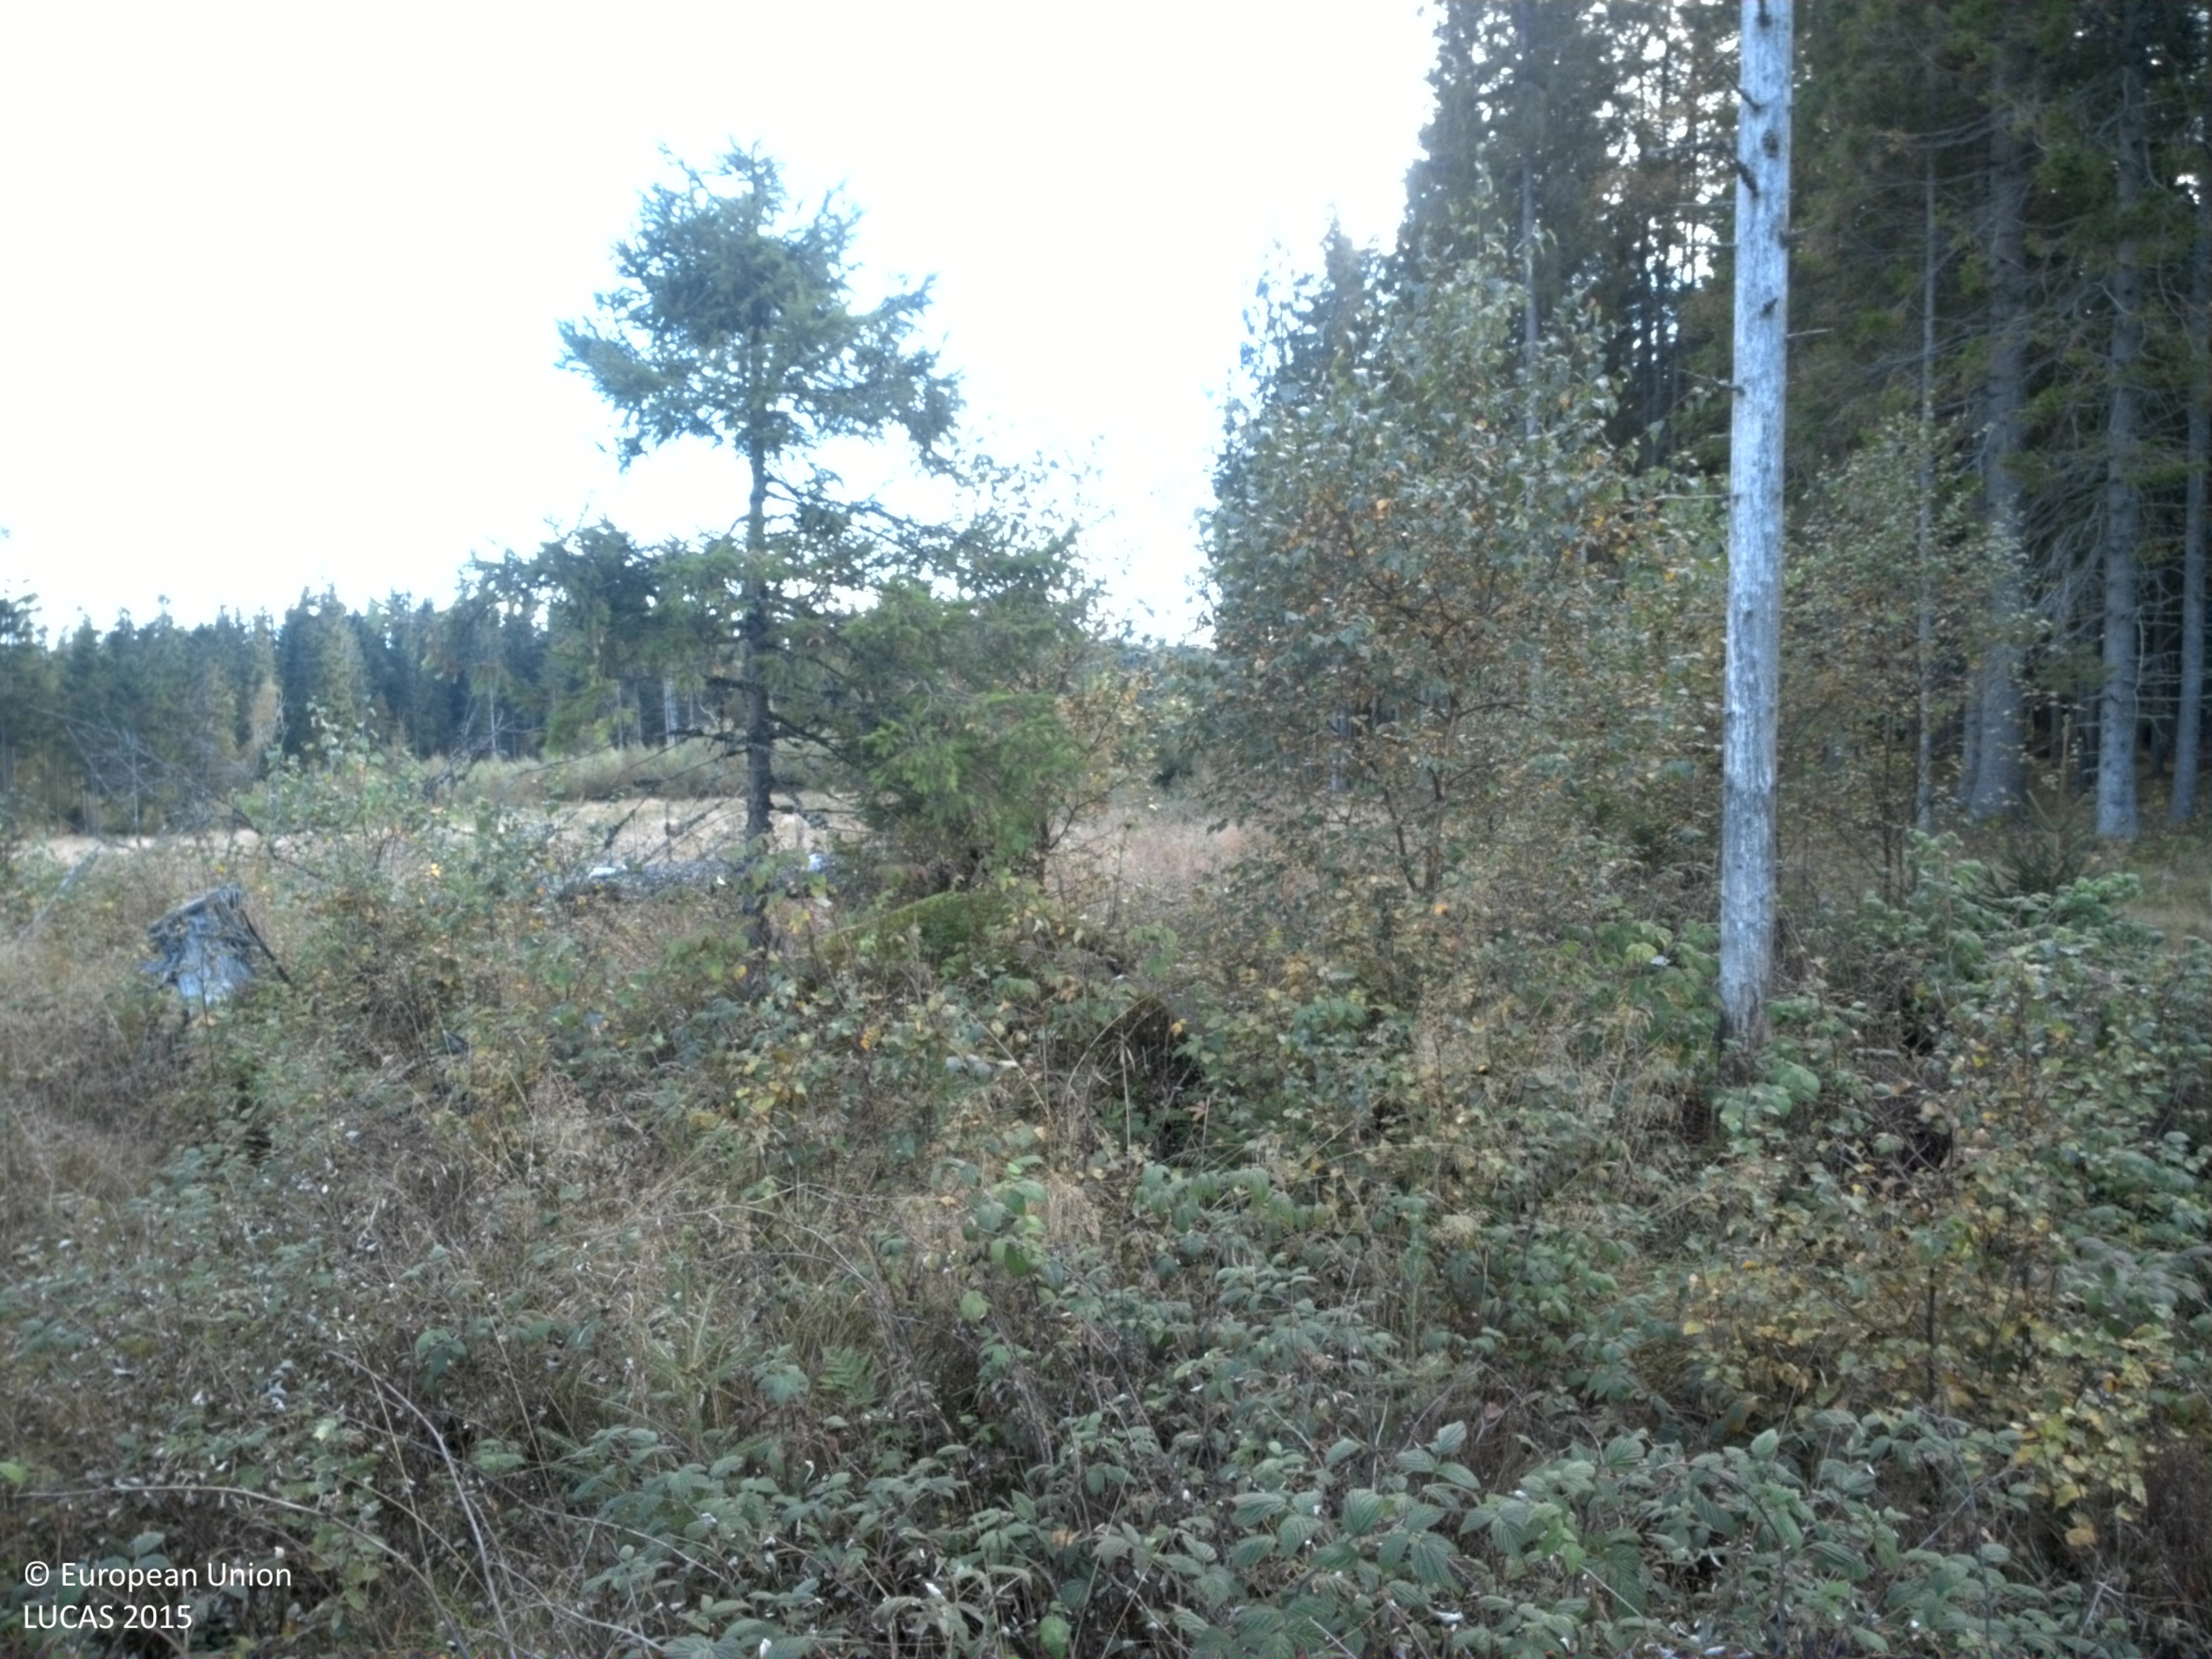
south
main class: Shrubland
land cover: Shrubland with sparse tree cover
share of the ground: 50 - 75 %
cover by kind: herbaceous plants 50 %, shrubs 45 %, broadleaved forest trees 5 %
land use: Forestry
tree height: < 5 m
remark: Clear cut
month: September
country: SE
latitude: 57.8775
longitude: 13.1146
